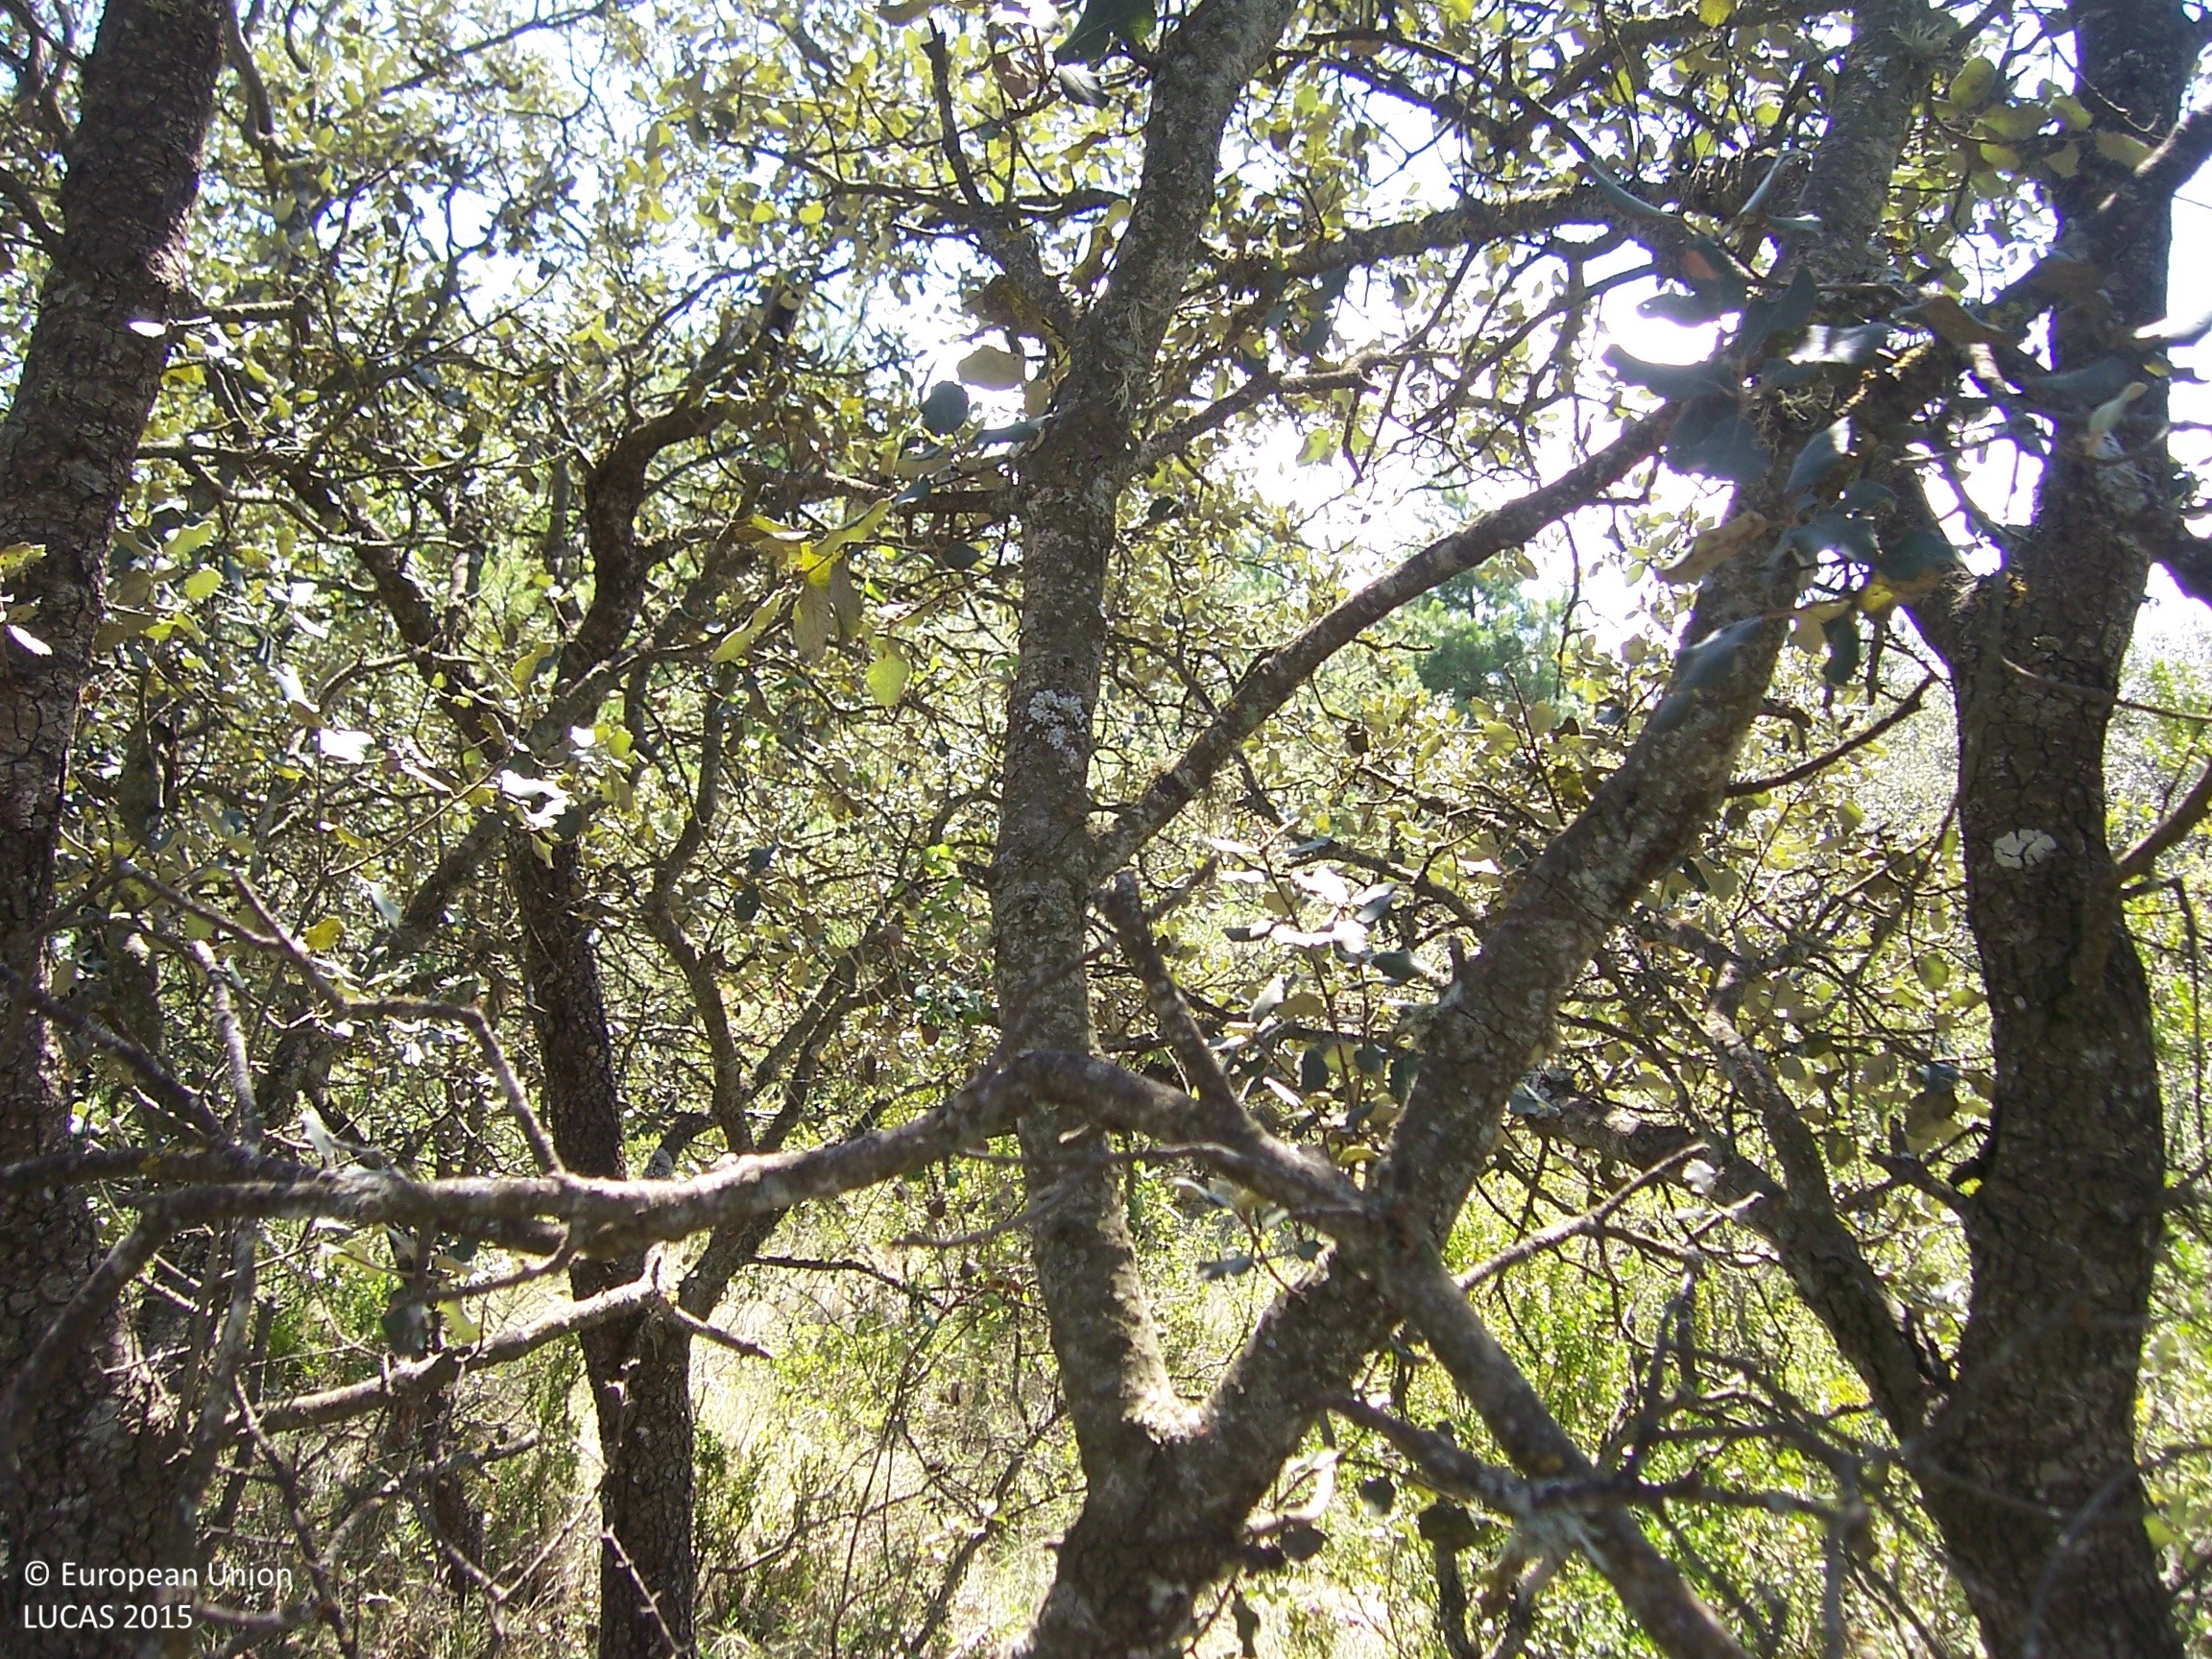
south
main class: Woodland
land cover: Pine dominated mixed woodland
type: coniferous forest of the mediterranean region
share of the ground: > 75 %
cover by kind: coniferous forest trees 40 %, broadleaved forest trees 30 %, shrubs 20 %, herbaceous plants 10 %
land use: Semi-natural and natural areas not in use
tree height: > 5 m
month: August
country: ES
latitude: 41.9580
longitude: 0.5621
